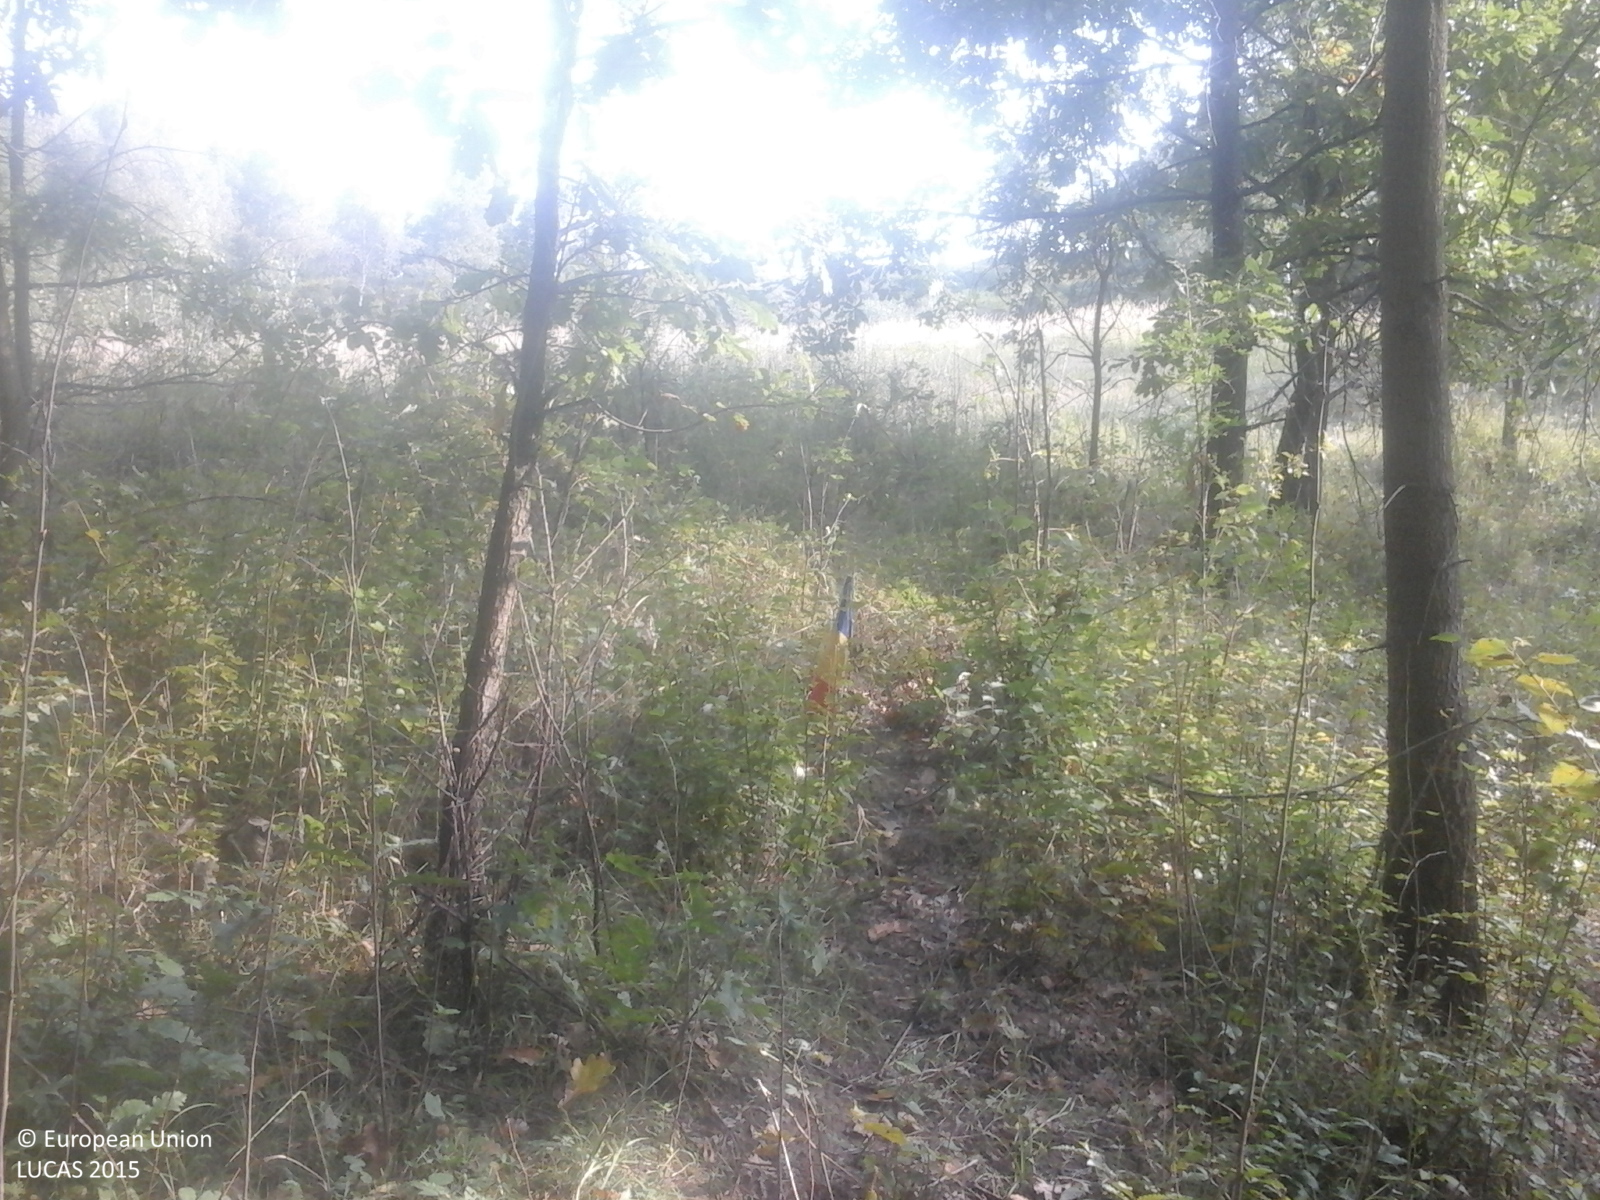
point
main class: Woodland
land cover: Broadleaved woodland
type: acidophilous oak and oak-birch forest
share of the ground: > 75 %
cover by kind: broadleaved forest trees 100 %
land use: Forestry
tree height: > 5 m
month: September
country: RO
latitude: 45.8841
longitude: 22.3775
